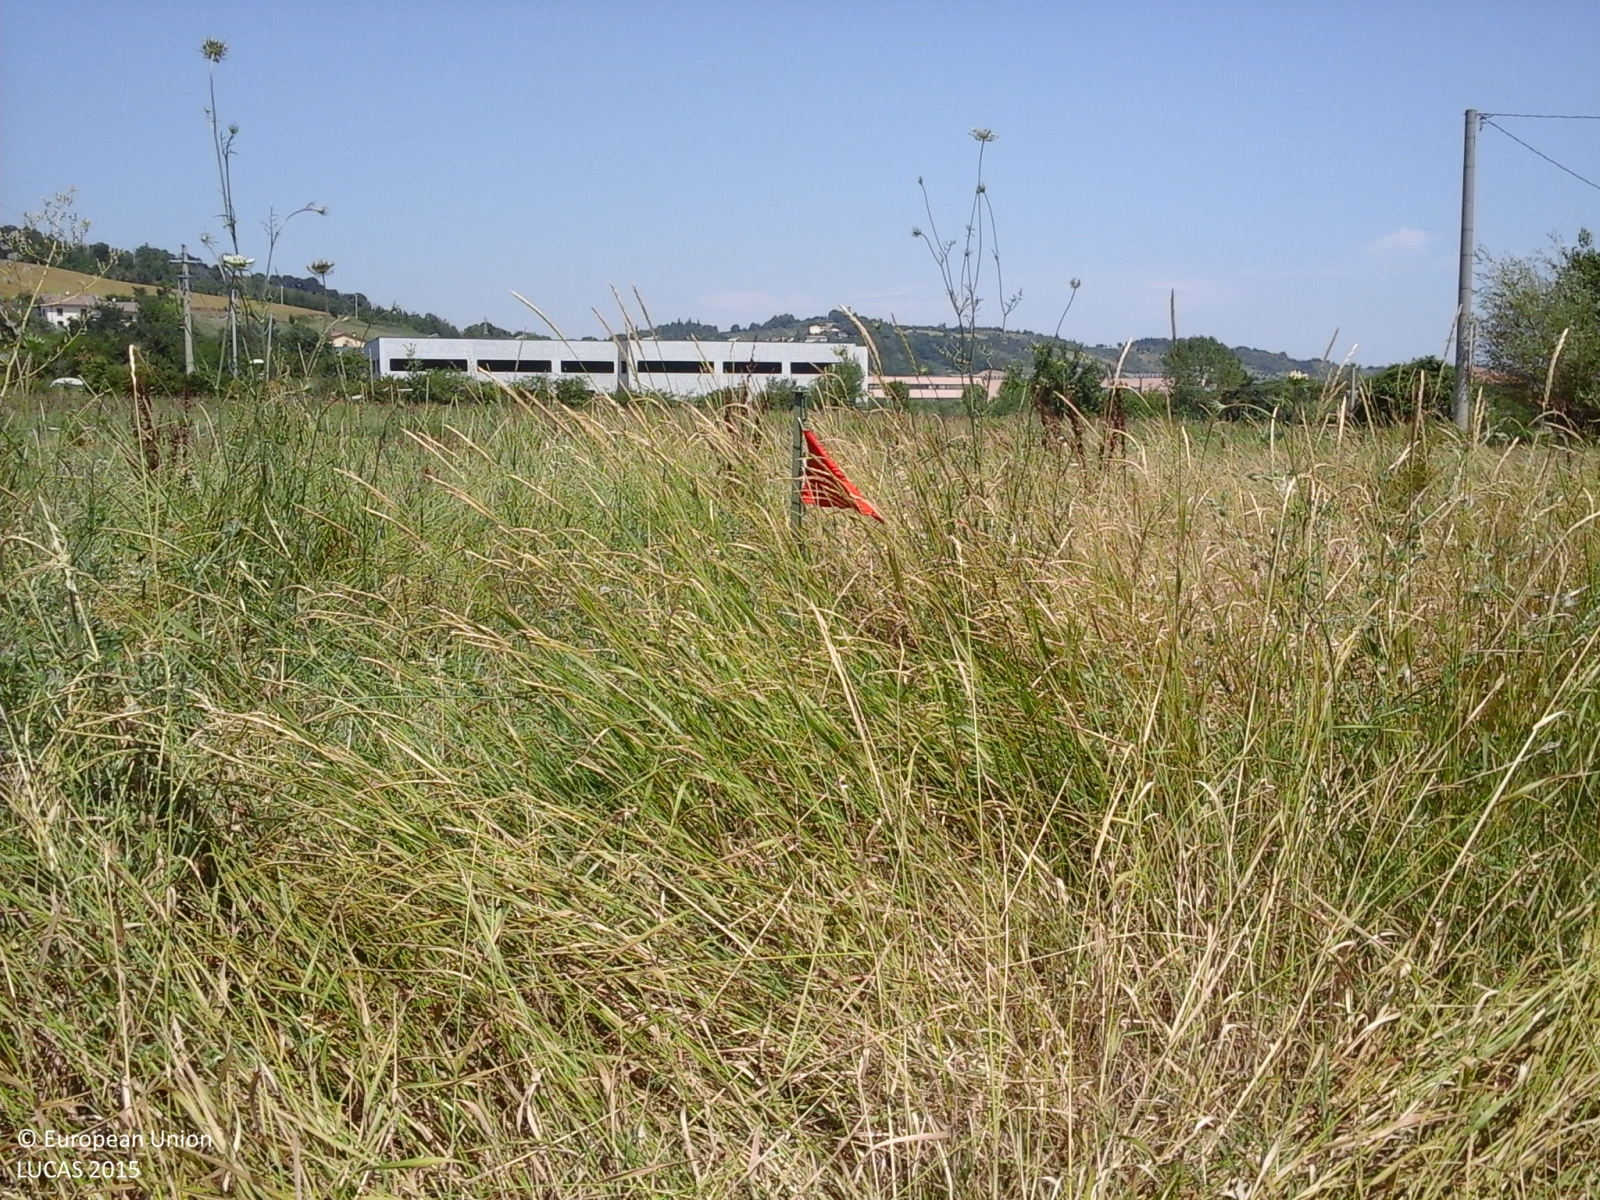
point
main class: Grassland
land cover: Spontaneously vegetated surfaces
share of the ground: > 75 %
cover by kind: herbaceous plants 100 %
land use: Fallow land
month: July
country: IT
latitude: 43.9980
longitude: 12.4012
